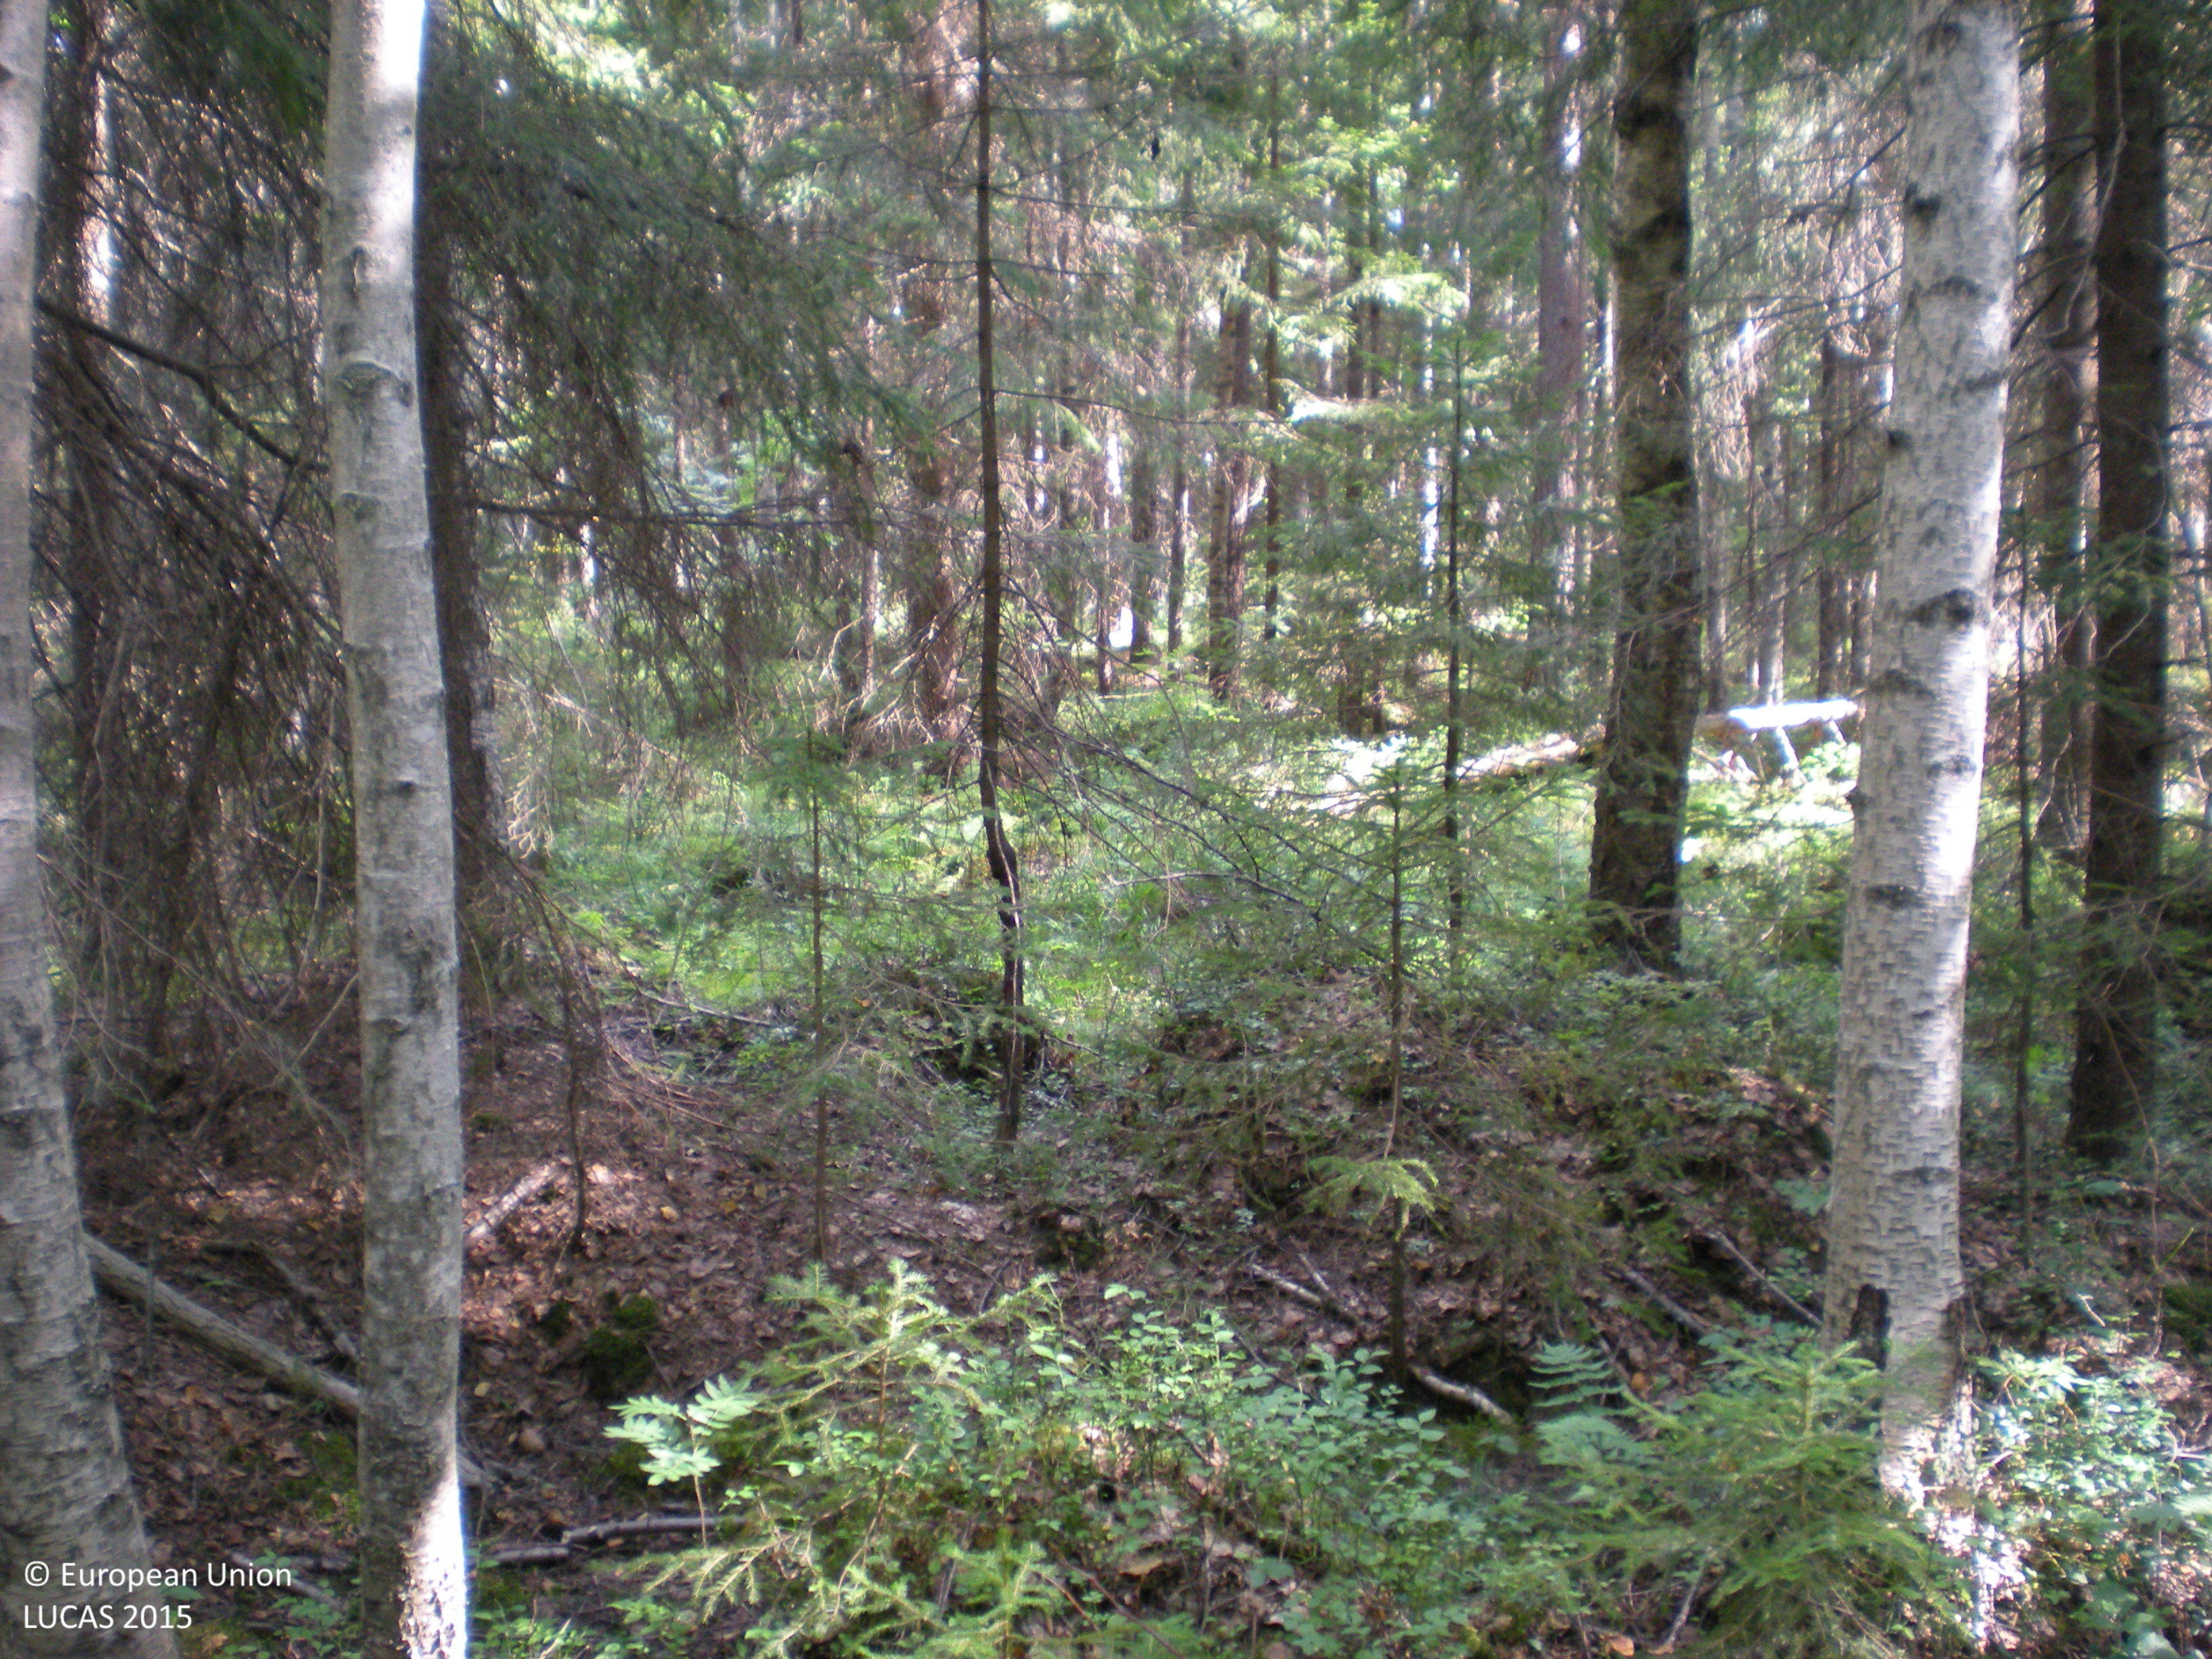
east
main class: Woodland
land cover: Spruce dominated mixed woodland
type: boreal forest
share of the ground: 50 - 75 %
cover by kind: coniferous forest trees 50 %, broadleaved forest trees 20 %, herbaceous plants 20 %, shrubs 5 %, lichens and mosses 5 %
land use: Forestry
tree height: > 5 m
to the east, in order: Spruce dominated mixed woodland; Other mixed woodland; Pine dominated mixed woodland; Broadleaved woodland; Pine dominated coniferous woodland; Other coniferous woodland; Pine dominated mixed woodland
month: August
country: SE
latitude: 60.6633
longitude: 17.2535
